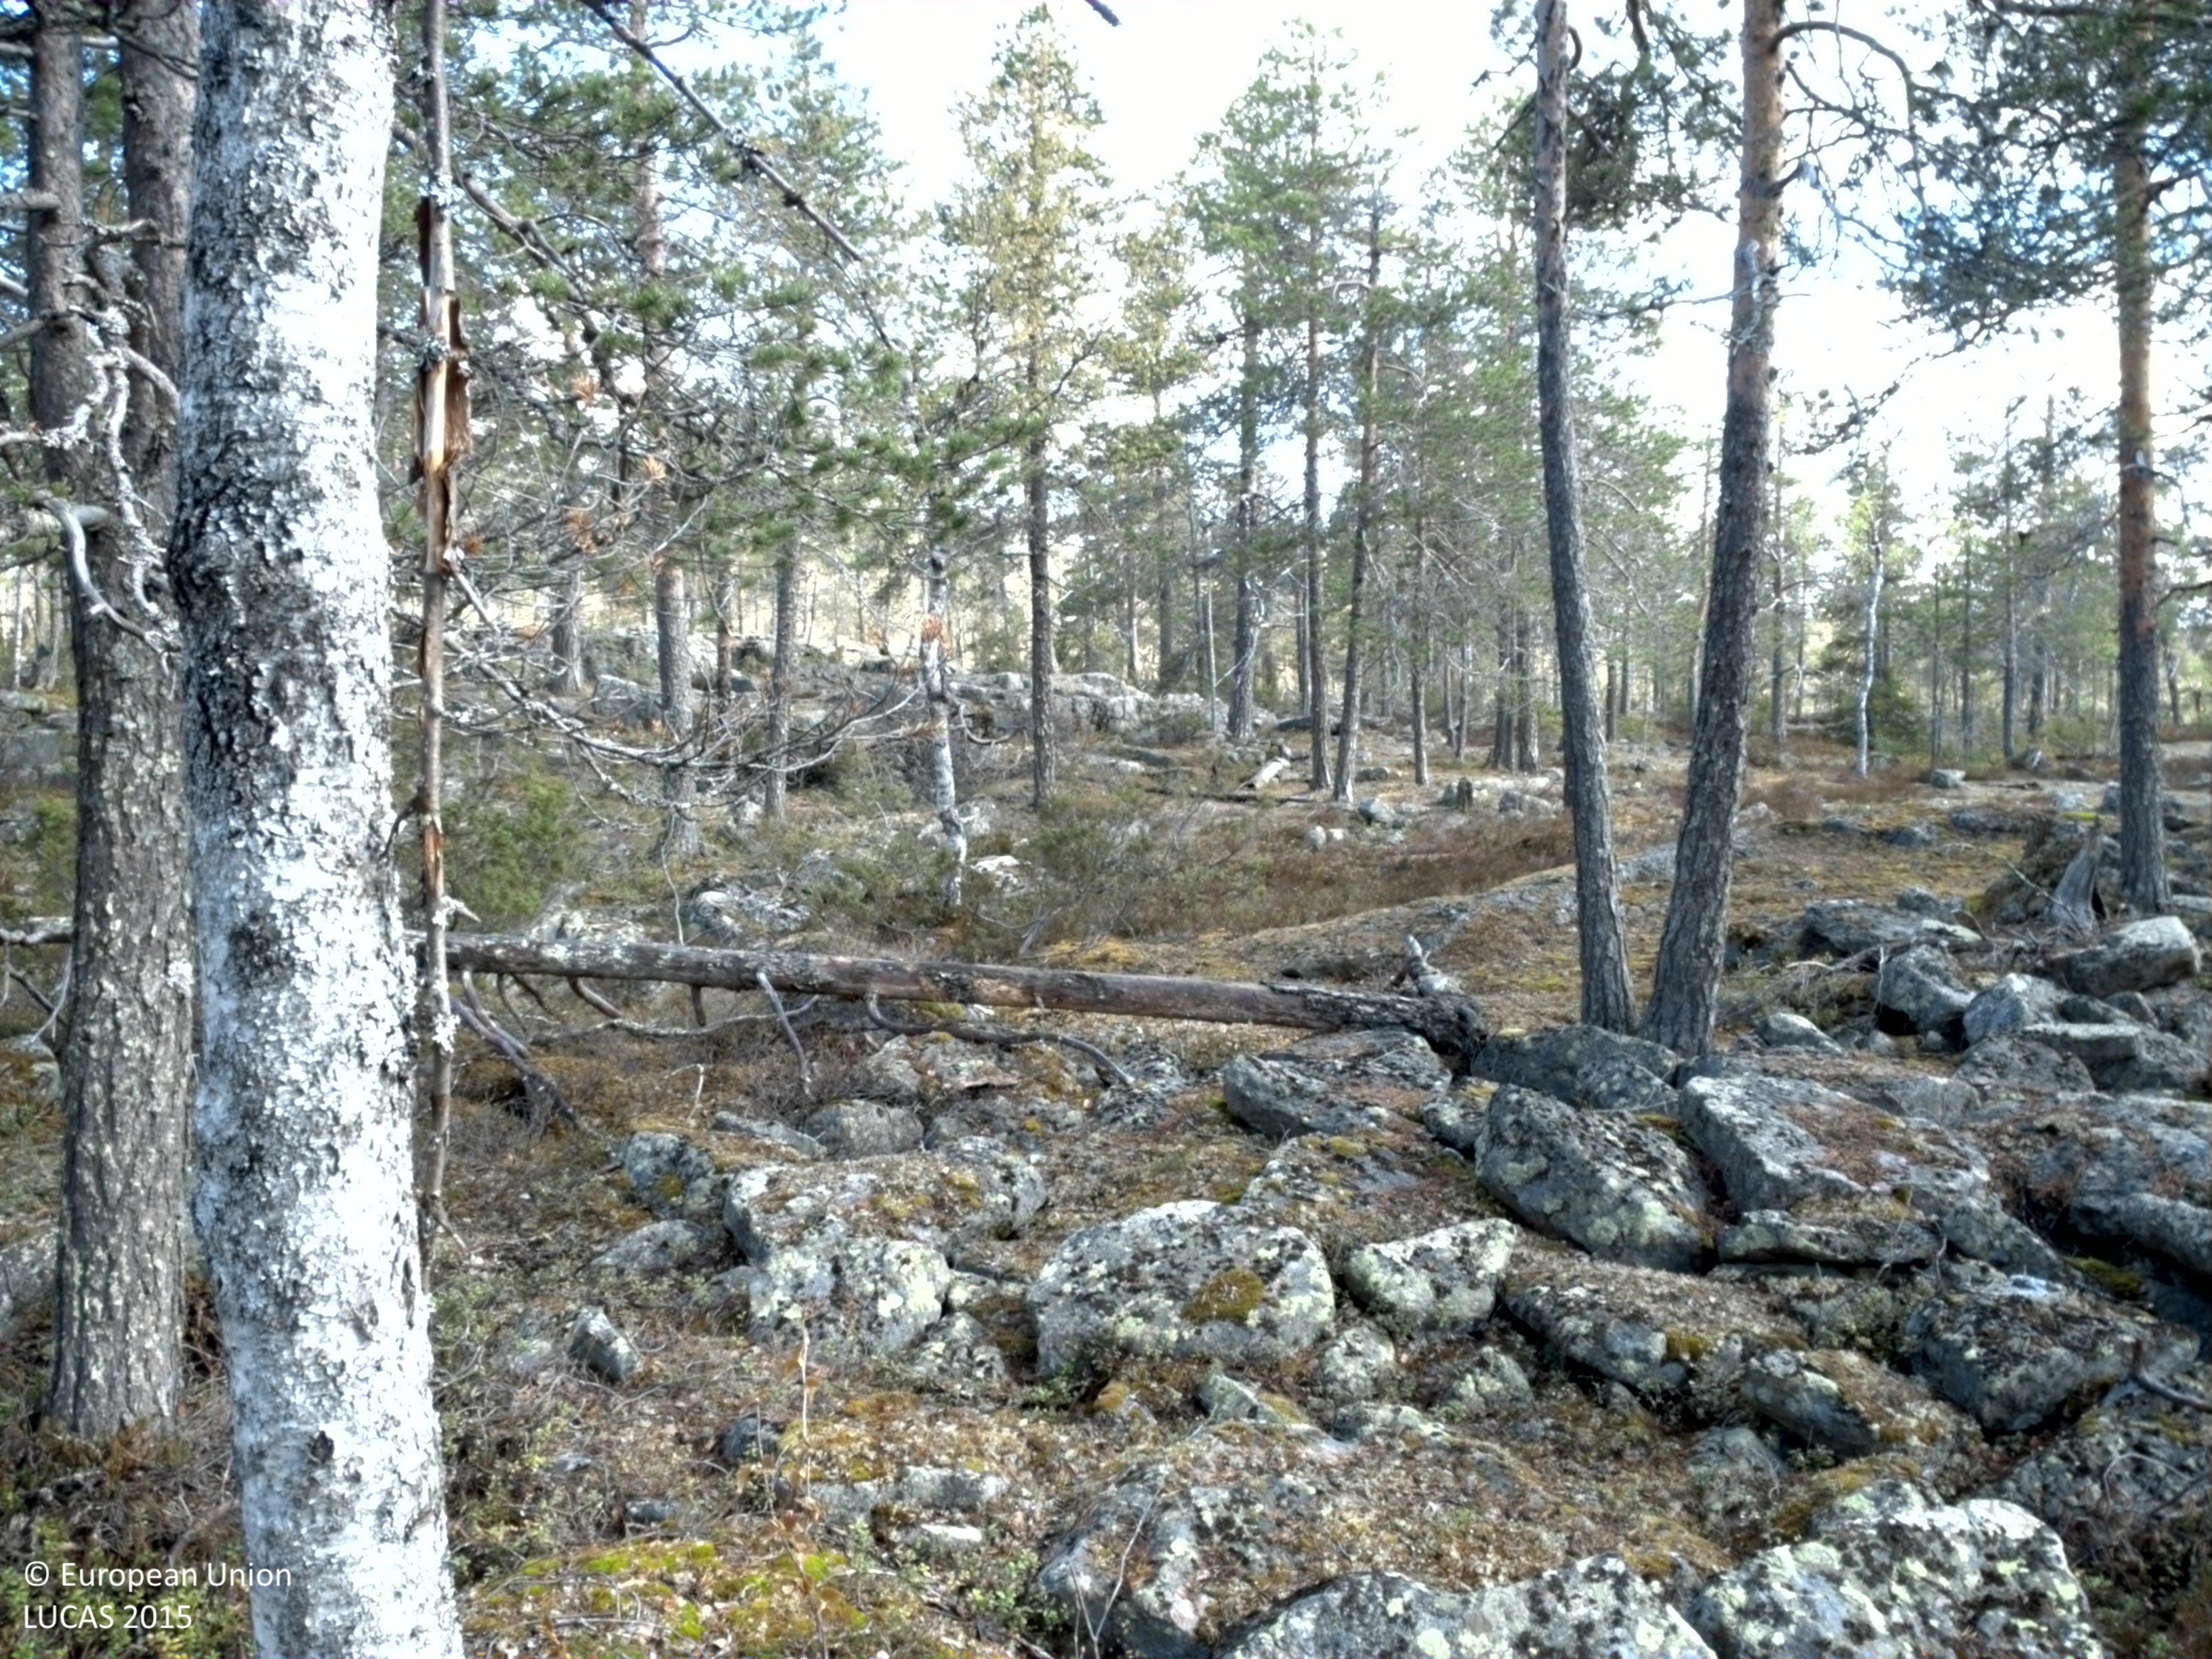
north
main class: Woodland
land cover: Pine dominated coniferous woodland
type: boreal forest
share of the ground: 25 - 50 %
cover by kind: shrubs 45 %, coniferous forest trees 35 %, lichens and mosses 10 %, consolidated bare surface 10 %
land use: Forestry
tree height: > 5 m
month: June
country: SE
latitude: 66.4100
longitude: 23.5337
